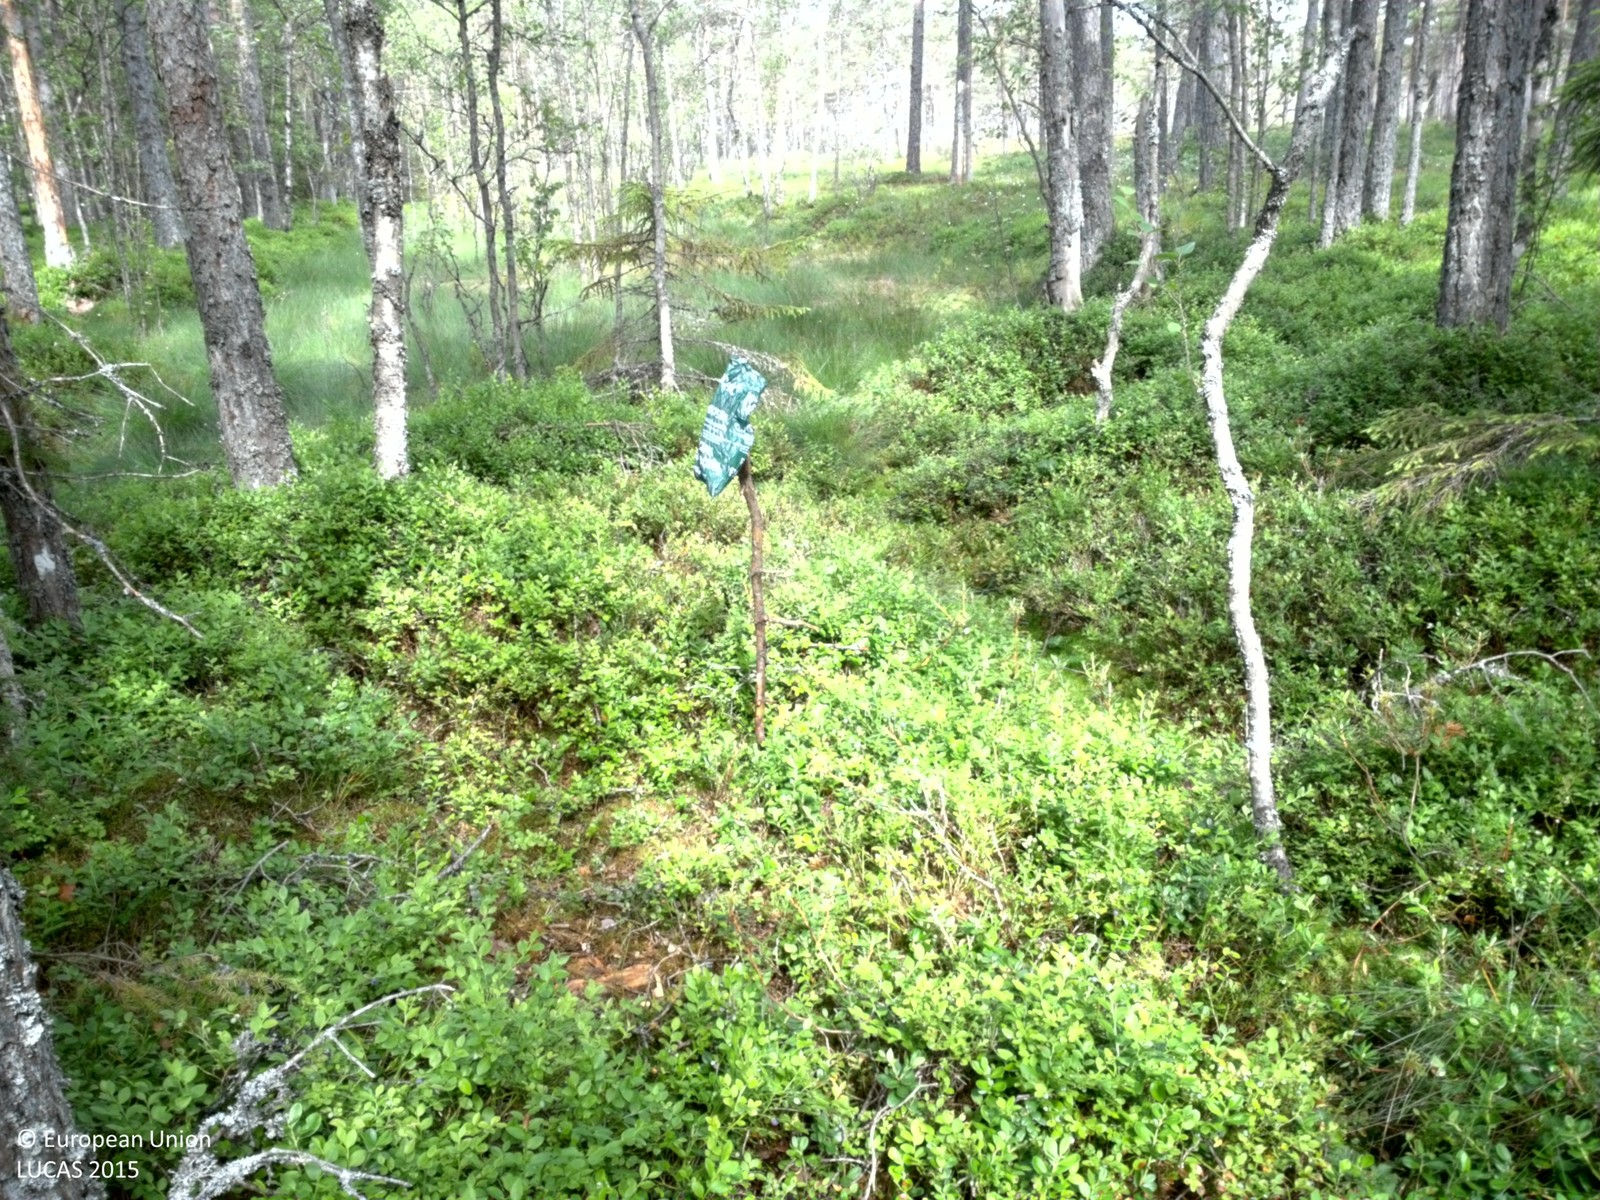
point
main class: Woodland
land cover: Pine dominated coniferous woodland
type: boreal forest
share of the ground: 50 - 75 %
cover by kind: coniferous forest trees 70 %, lichens and mosses 30 %
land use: Forestry
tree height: > 5 m
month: July
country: SE
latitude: 57.6363
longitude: 14.6016
